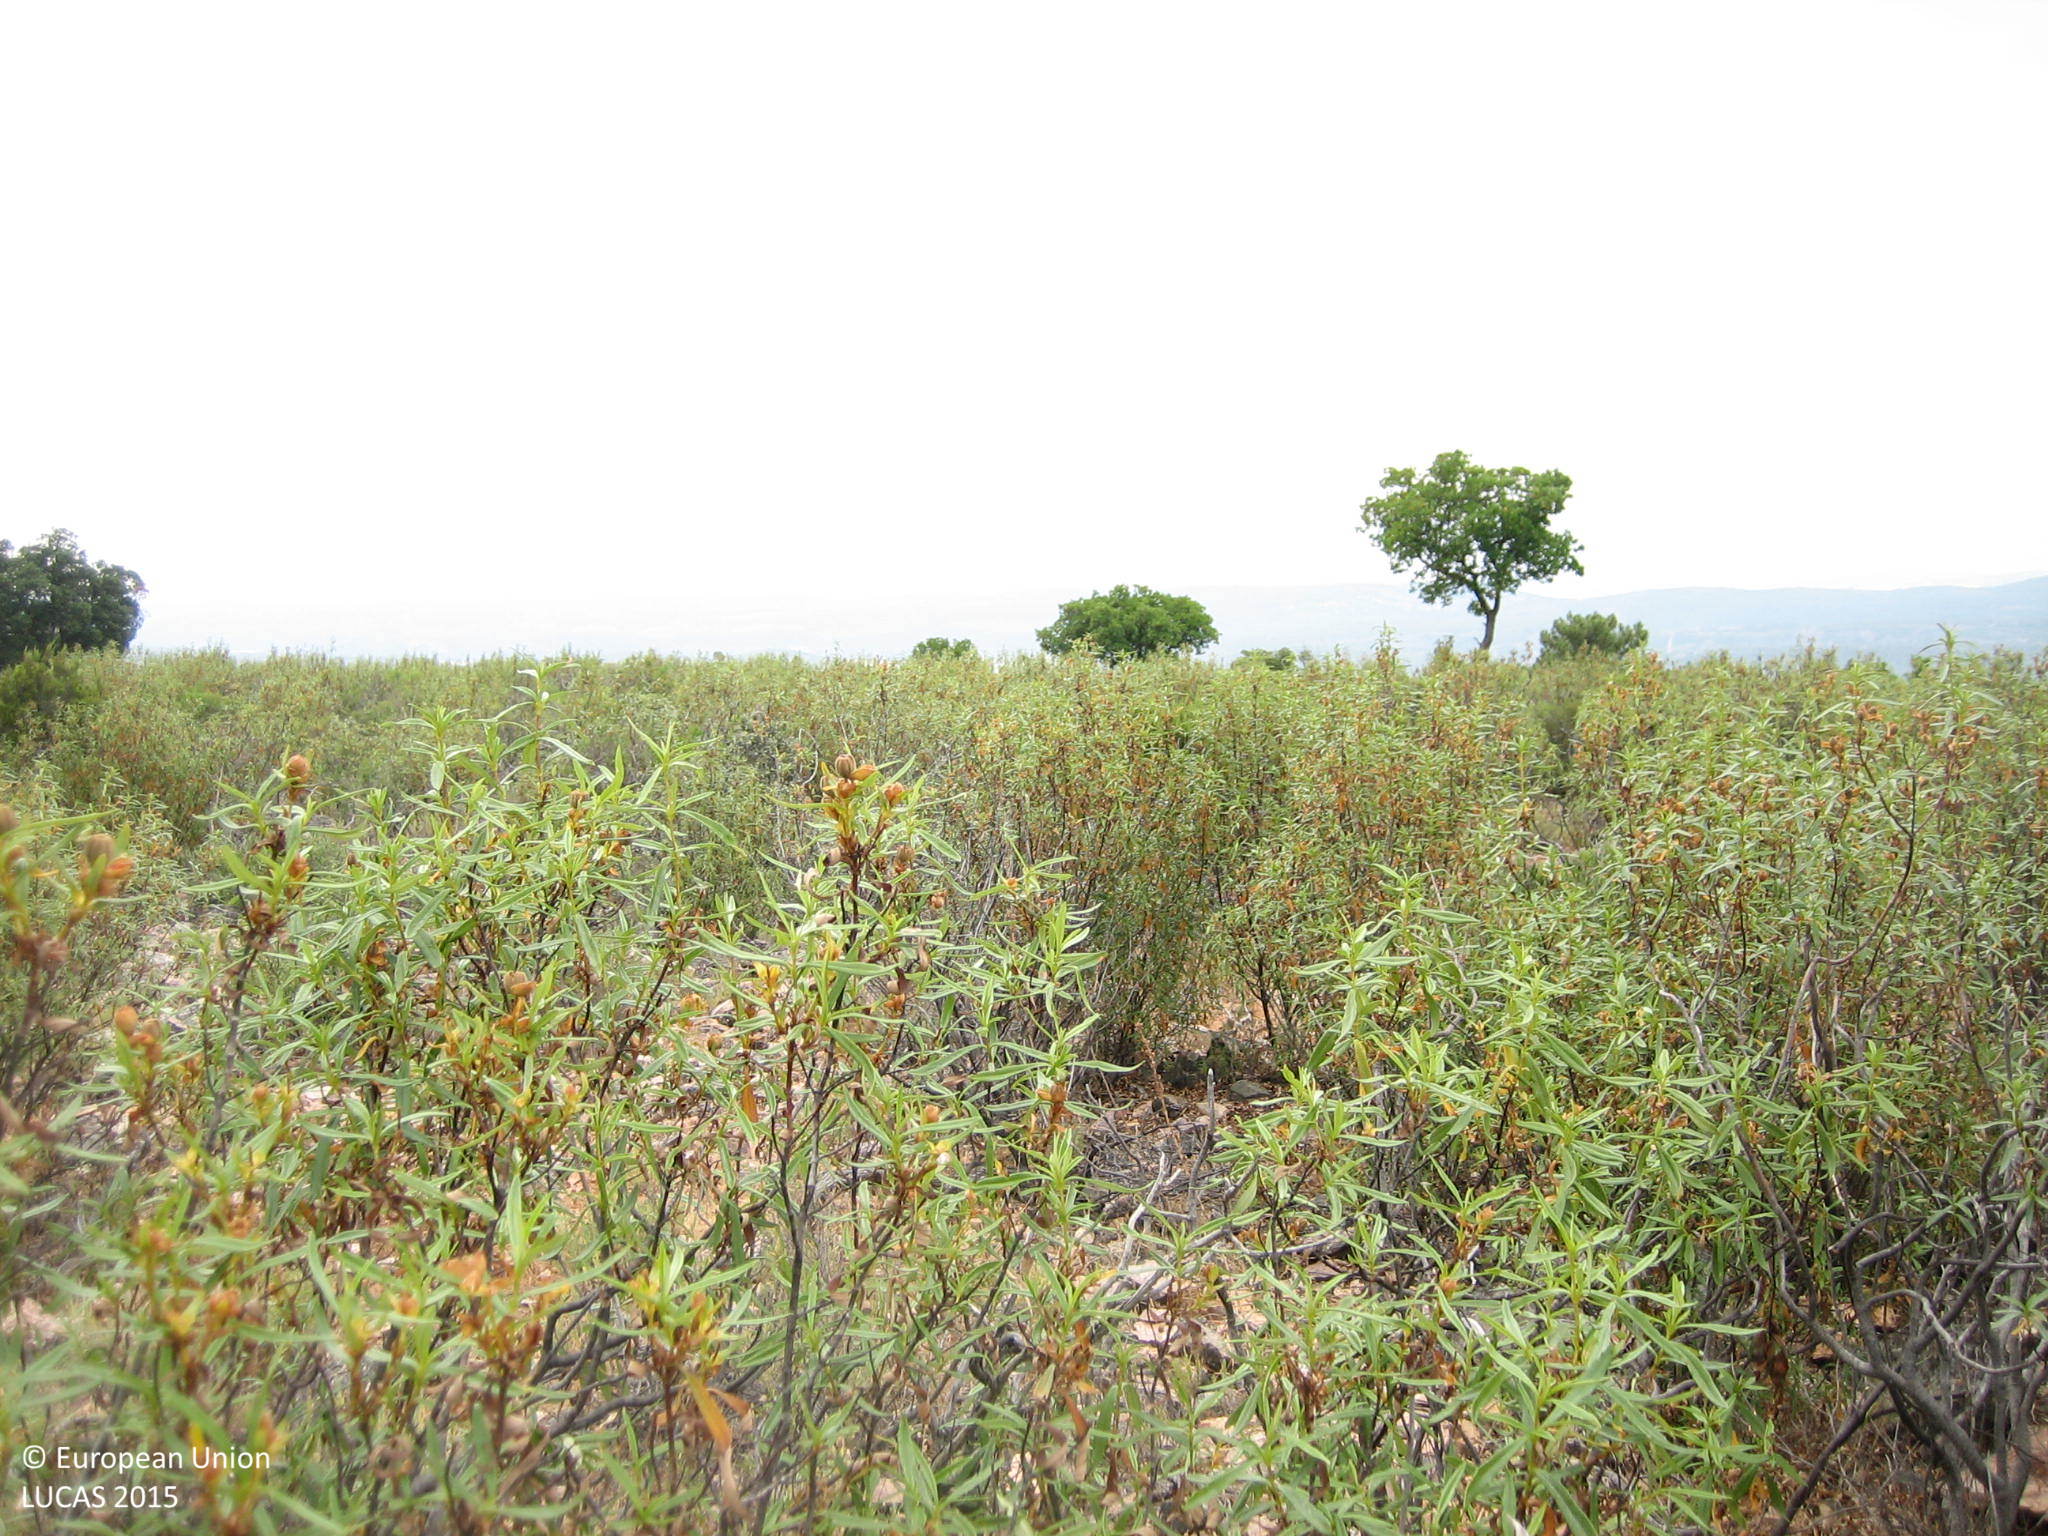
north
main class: Shrubland
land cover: Shrubland without tree cover
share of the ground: > 75 %
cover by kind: shrubs 100 %
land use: Semi-natural and natural areas not in use
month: June
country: ES
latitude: 39.2857
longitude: -4.9132
